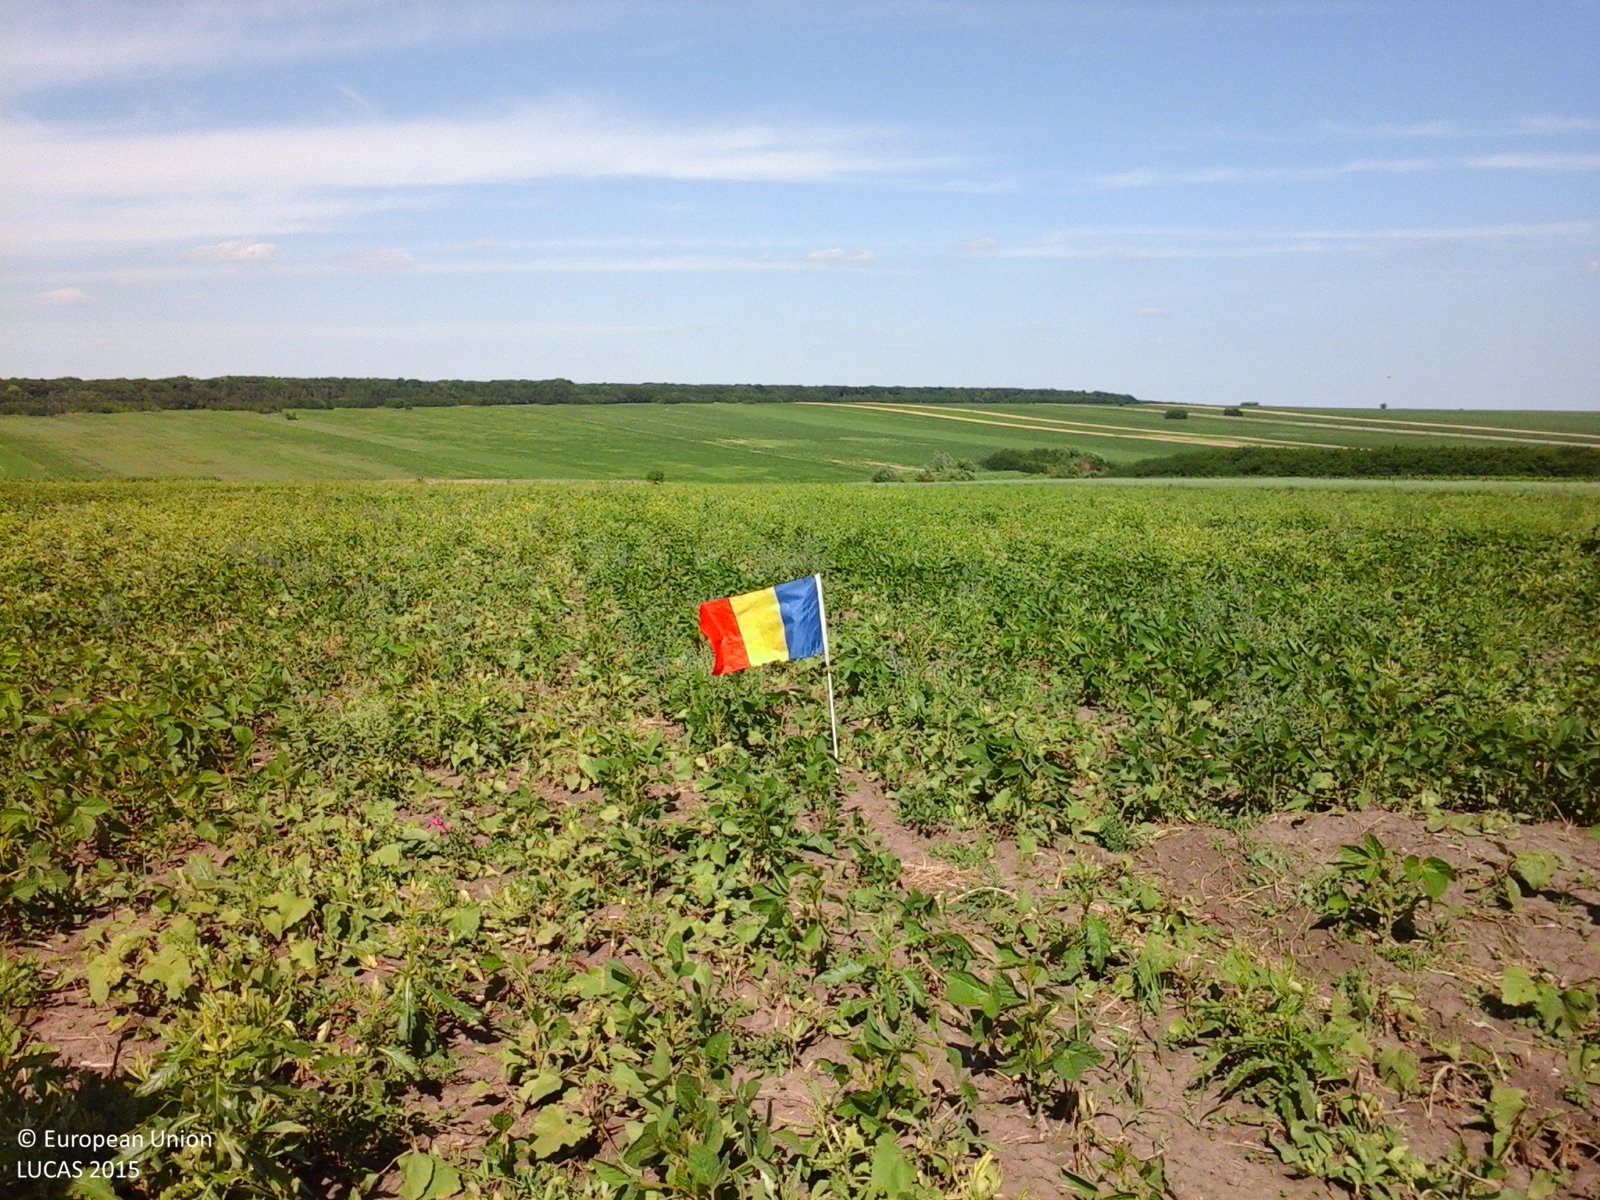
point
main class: Cropland
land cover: Soya
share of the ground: > 75 %
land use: Agriculture (excluding fallow land and kitchen gardens)
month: June
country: RO
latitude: 48.0747
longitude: 26.9499
